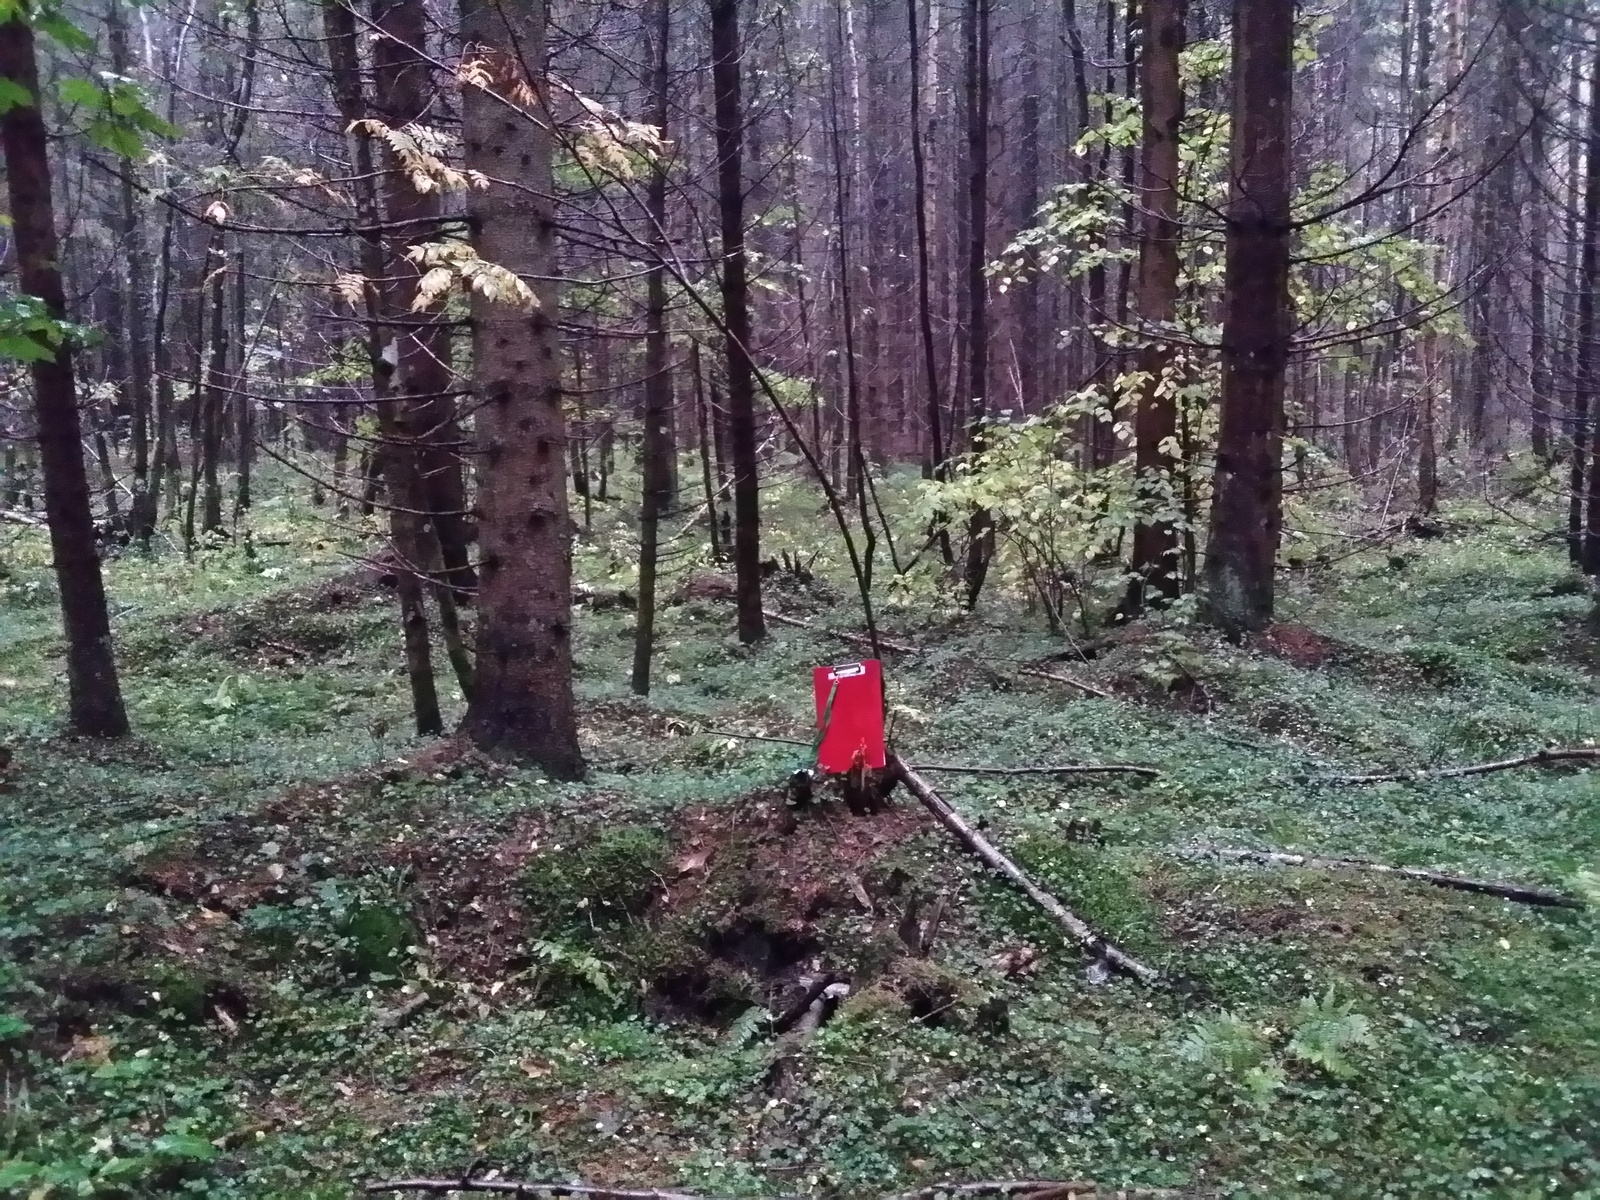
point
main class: Woodland
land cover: Spruce dominated coniferous woodland
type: hemiboreal forest and nemoral coniferous forest and mixed broadleaved-coniferous forest
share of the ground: > 75 %
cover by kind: coniferous forest trees 75 %, broadleaved forest trees 15 %, herbaceous plants 5 %, lichens and mosses 5 %
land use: Forestry
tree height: > 5 m
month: September
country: LV
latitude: 57.4597
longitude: 27.3894
